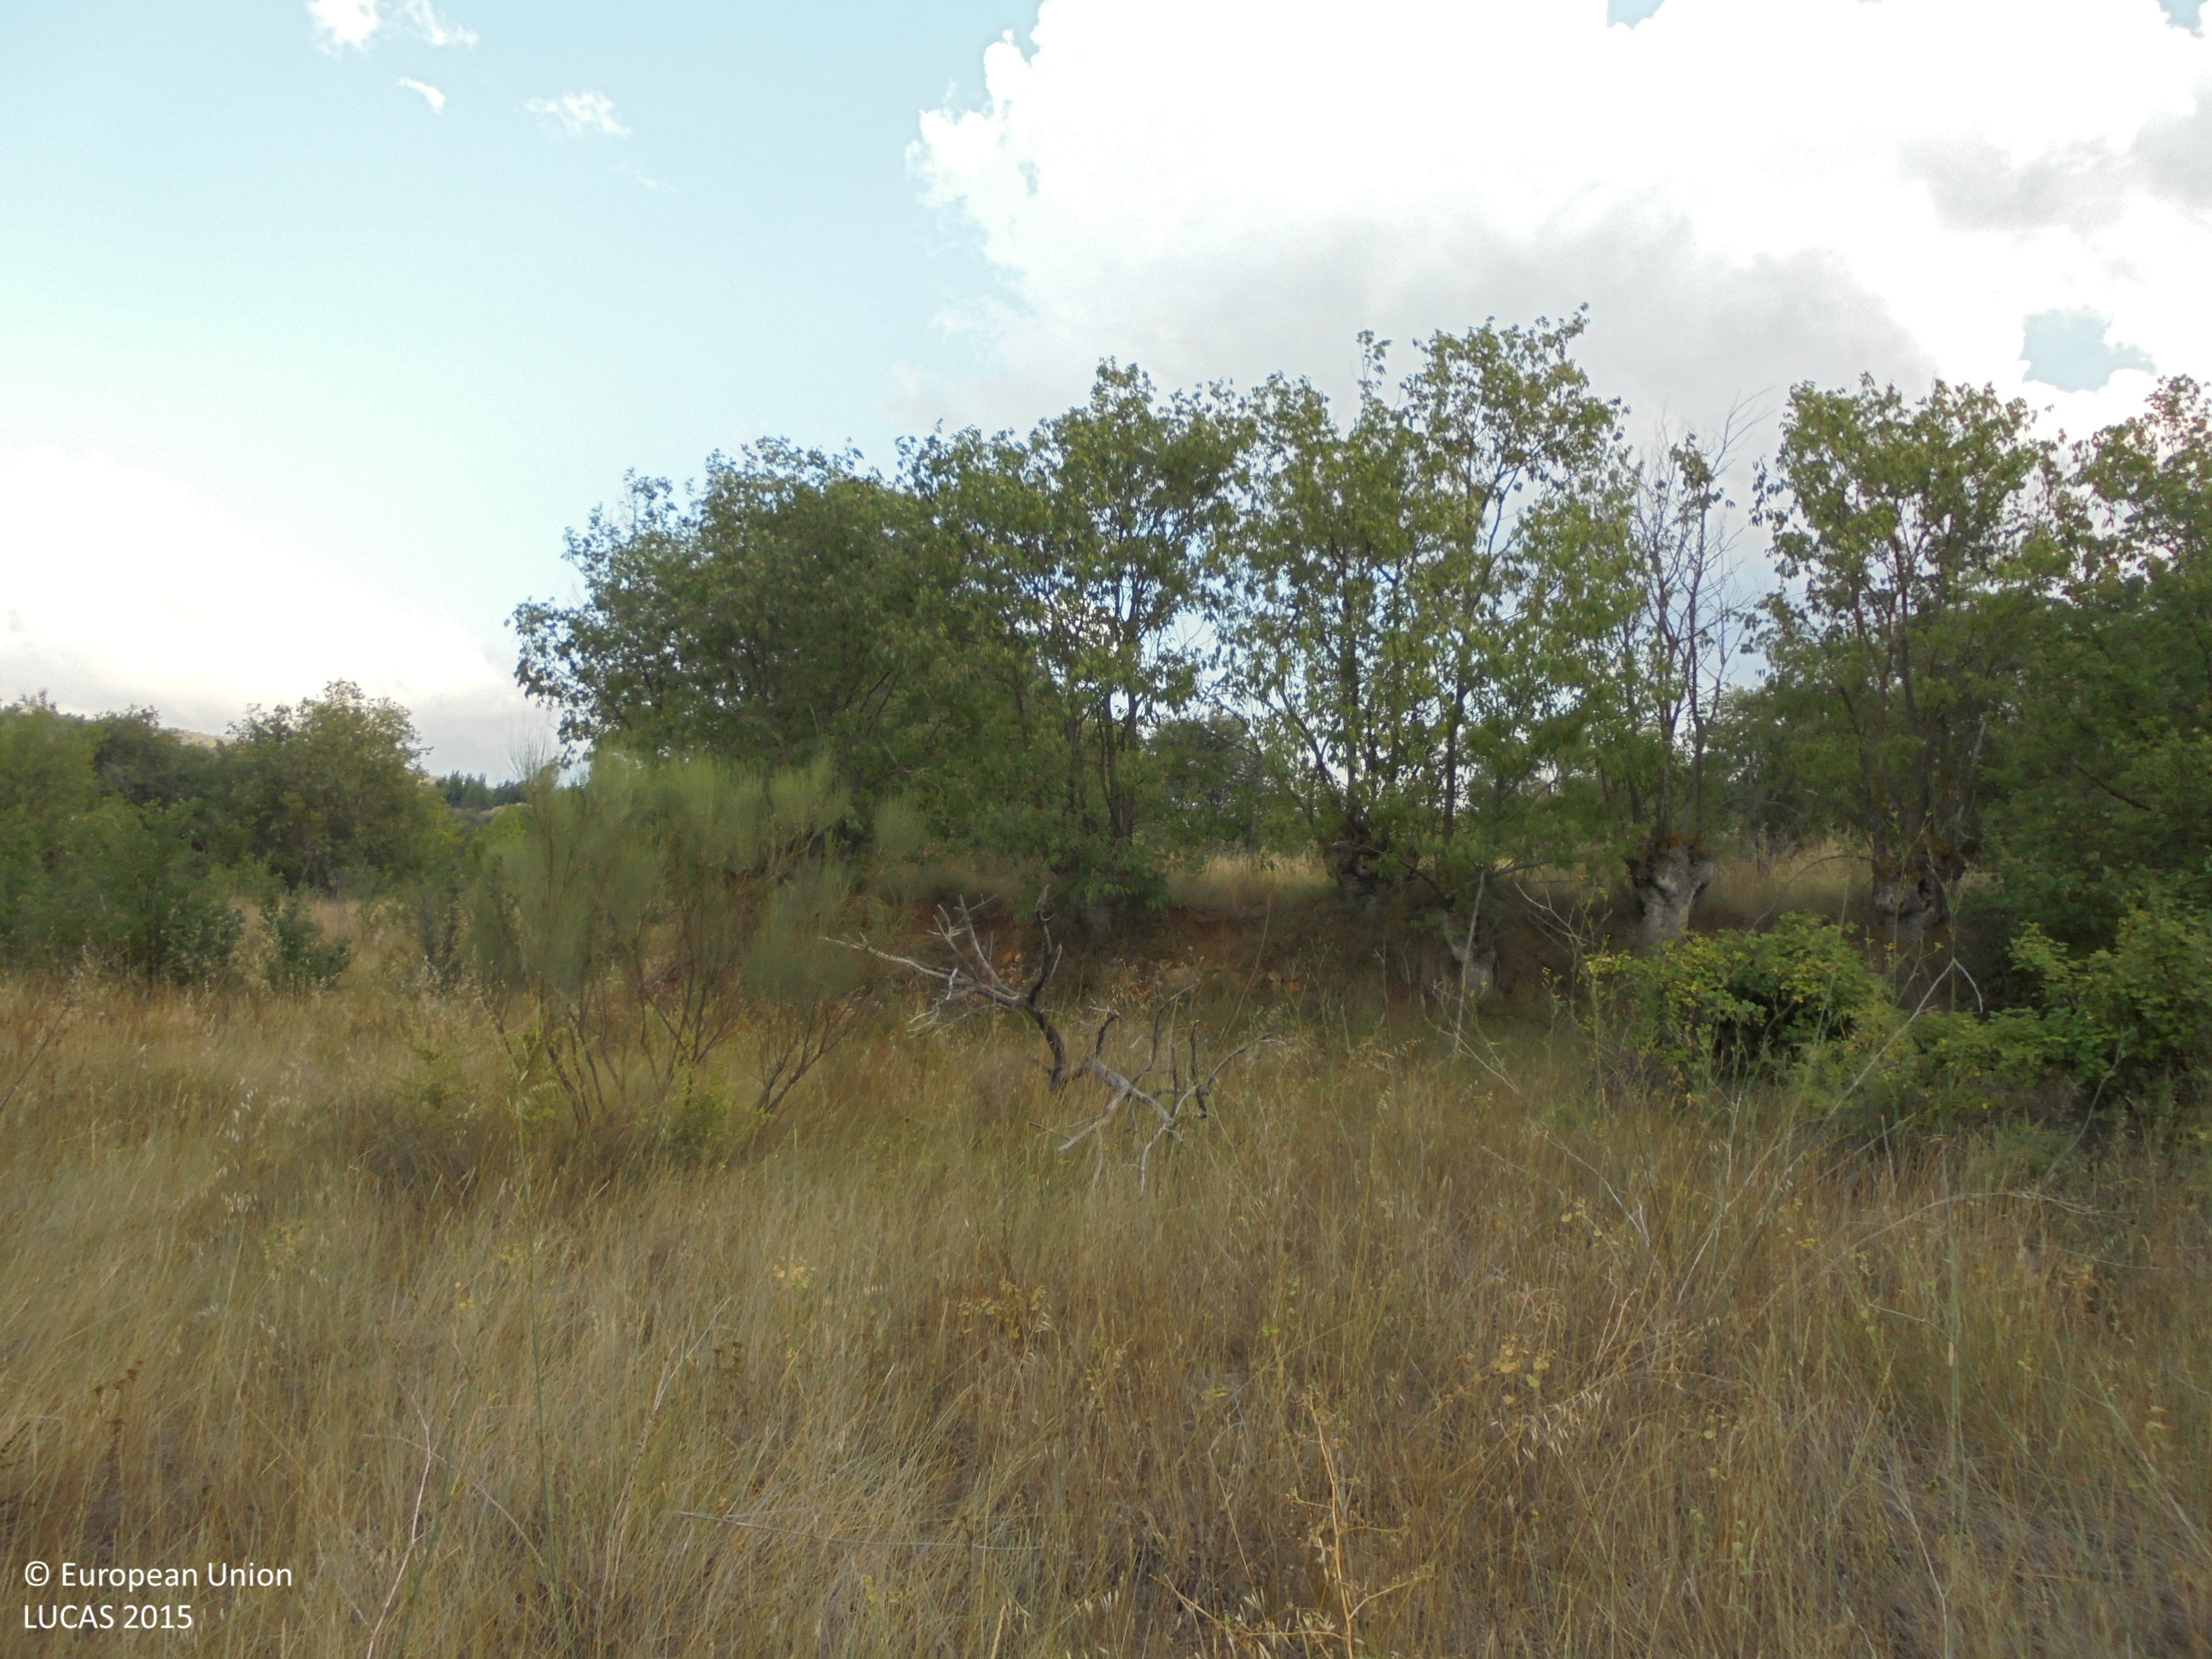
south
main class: Grassland
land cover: Grassland with sparse tree/shrub cover
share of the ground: > 75 %
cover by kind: herbaceous plants 95 %, broadleaved forest trees 5 %
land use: Abandoned areas
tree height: < 5 m
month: July
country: ES
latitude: 39.0949
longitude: -1.0383
